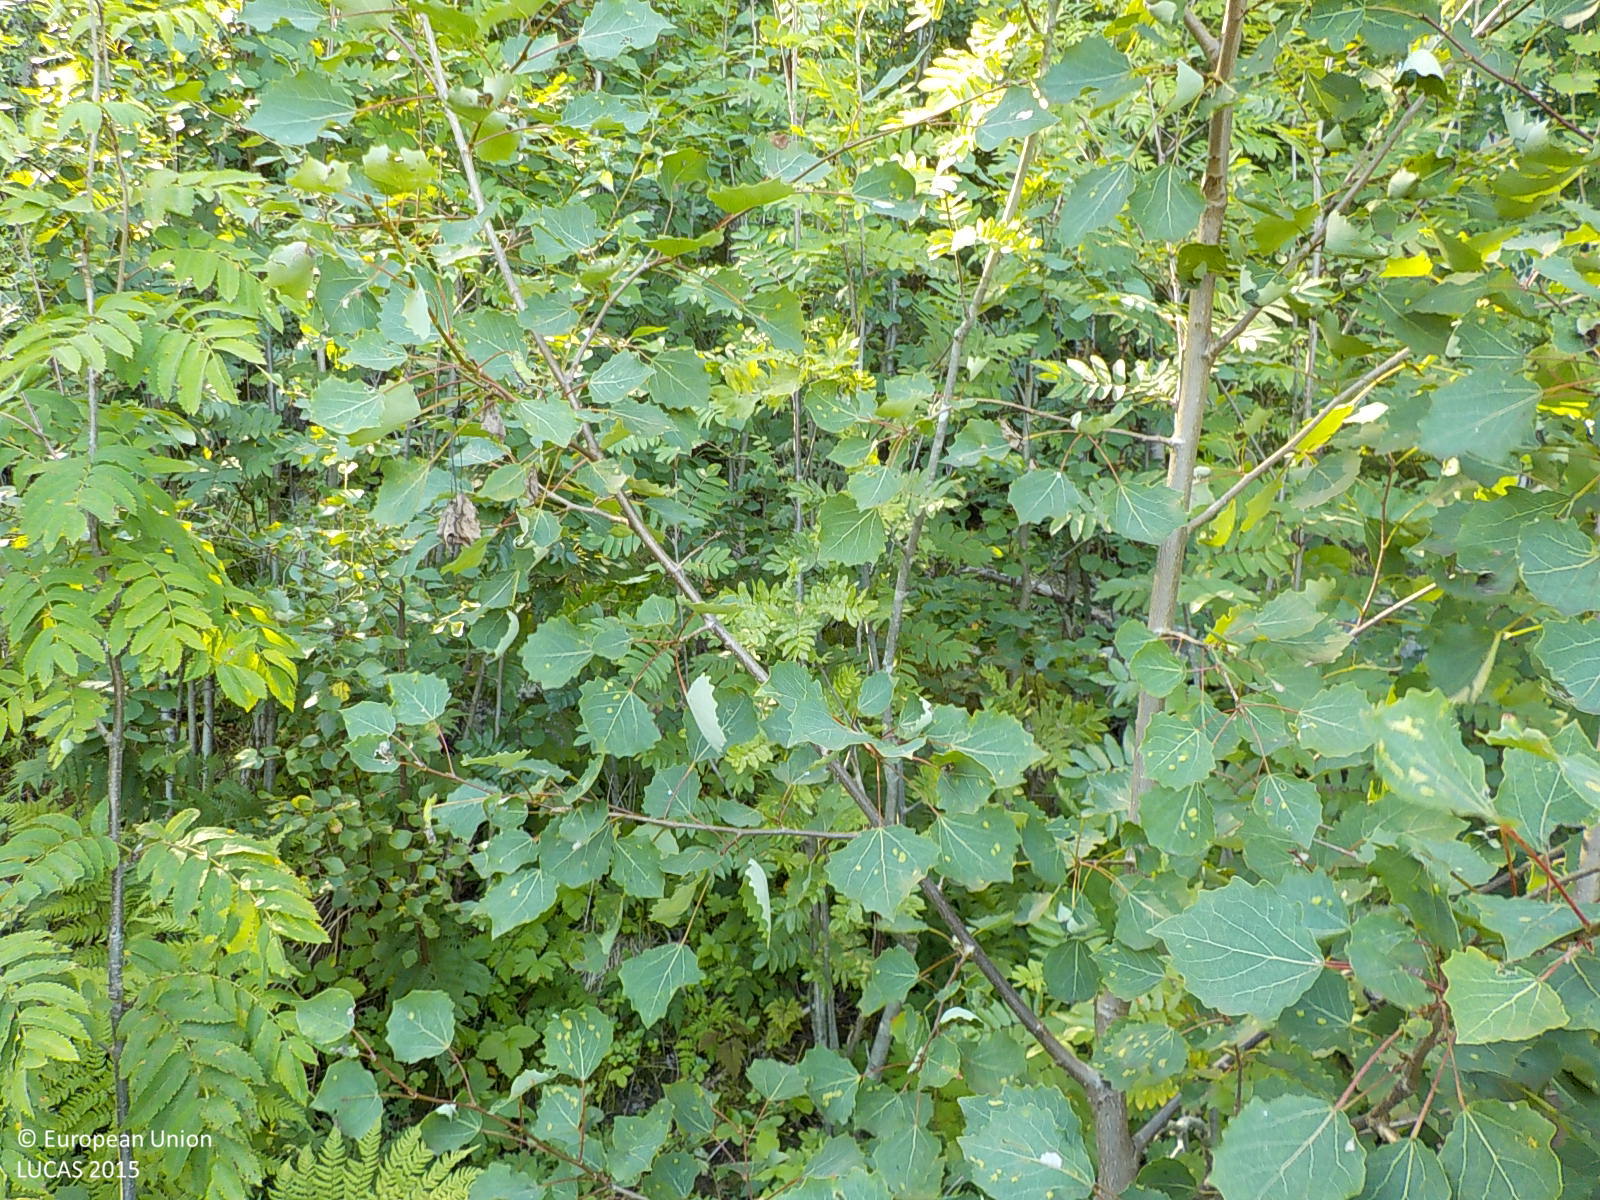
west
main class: Woodland
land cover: Broadleaved woodland
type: hemiboreal forest and nemoral coniferous forest and mixed broadleaved-coniferous forest
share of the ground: > 75 %
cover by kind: broadleaved forest trees 85 %, herbaceous plants 15 %
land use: Forestry
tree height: < 5 m
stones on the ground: 10 - 25 %
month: August
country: SE
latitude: 63.3318
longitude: 18.8654
